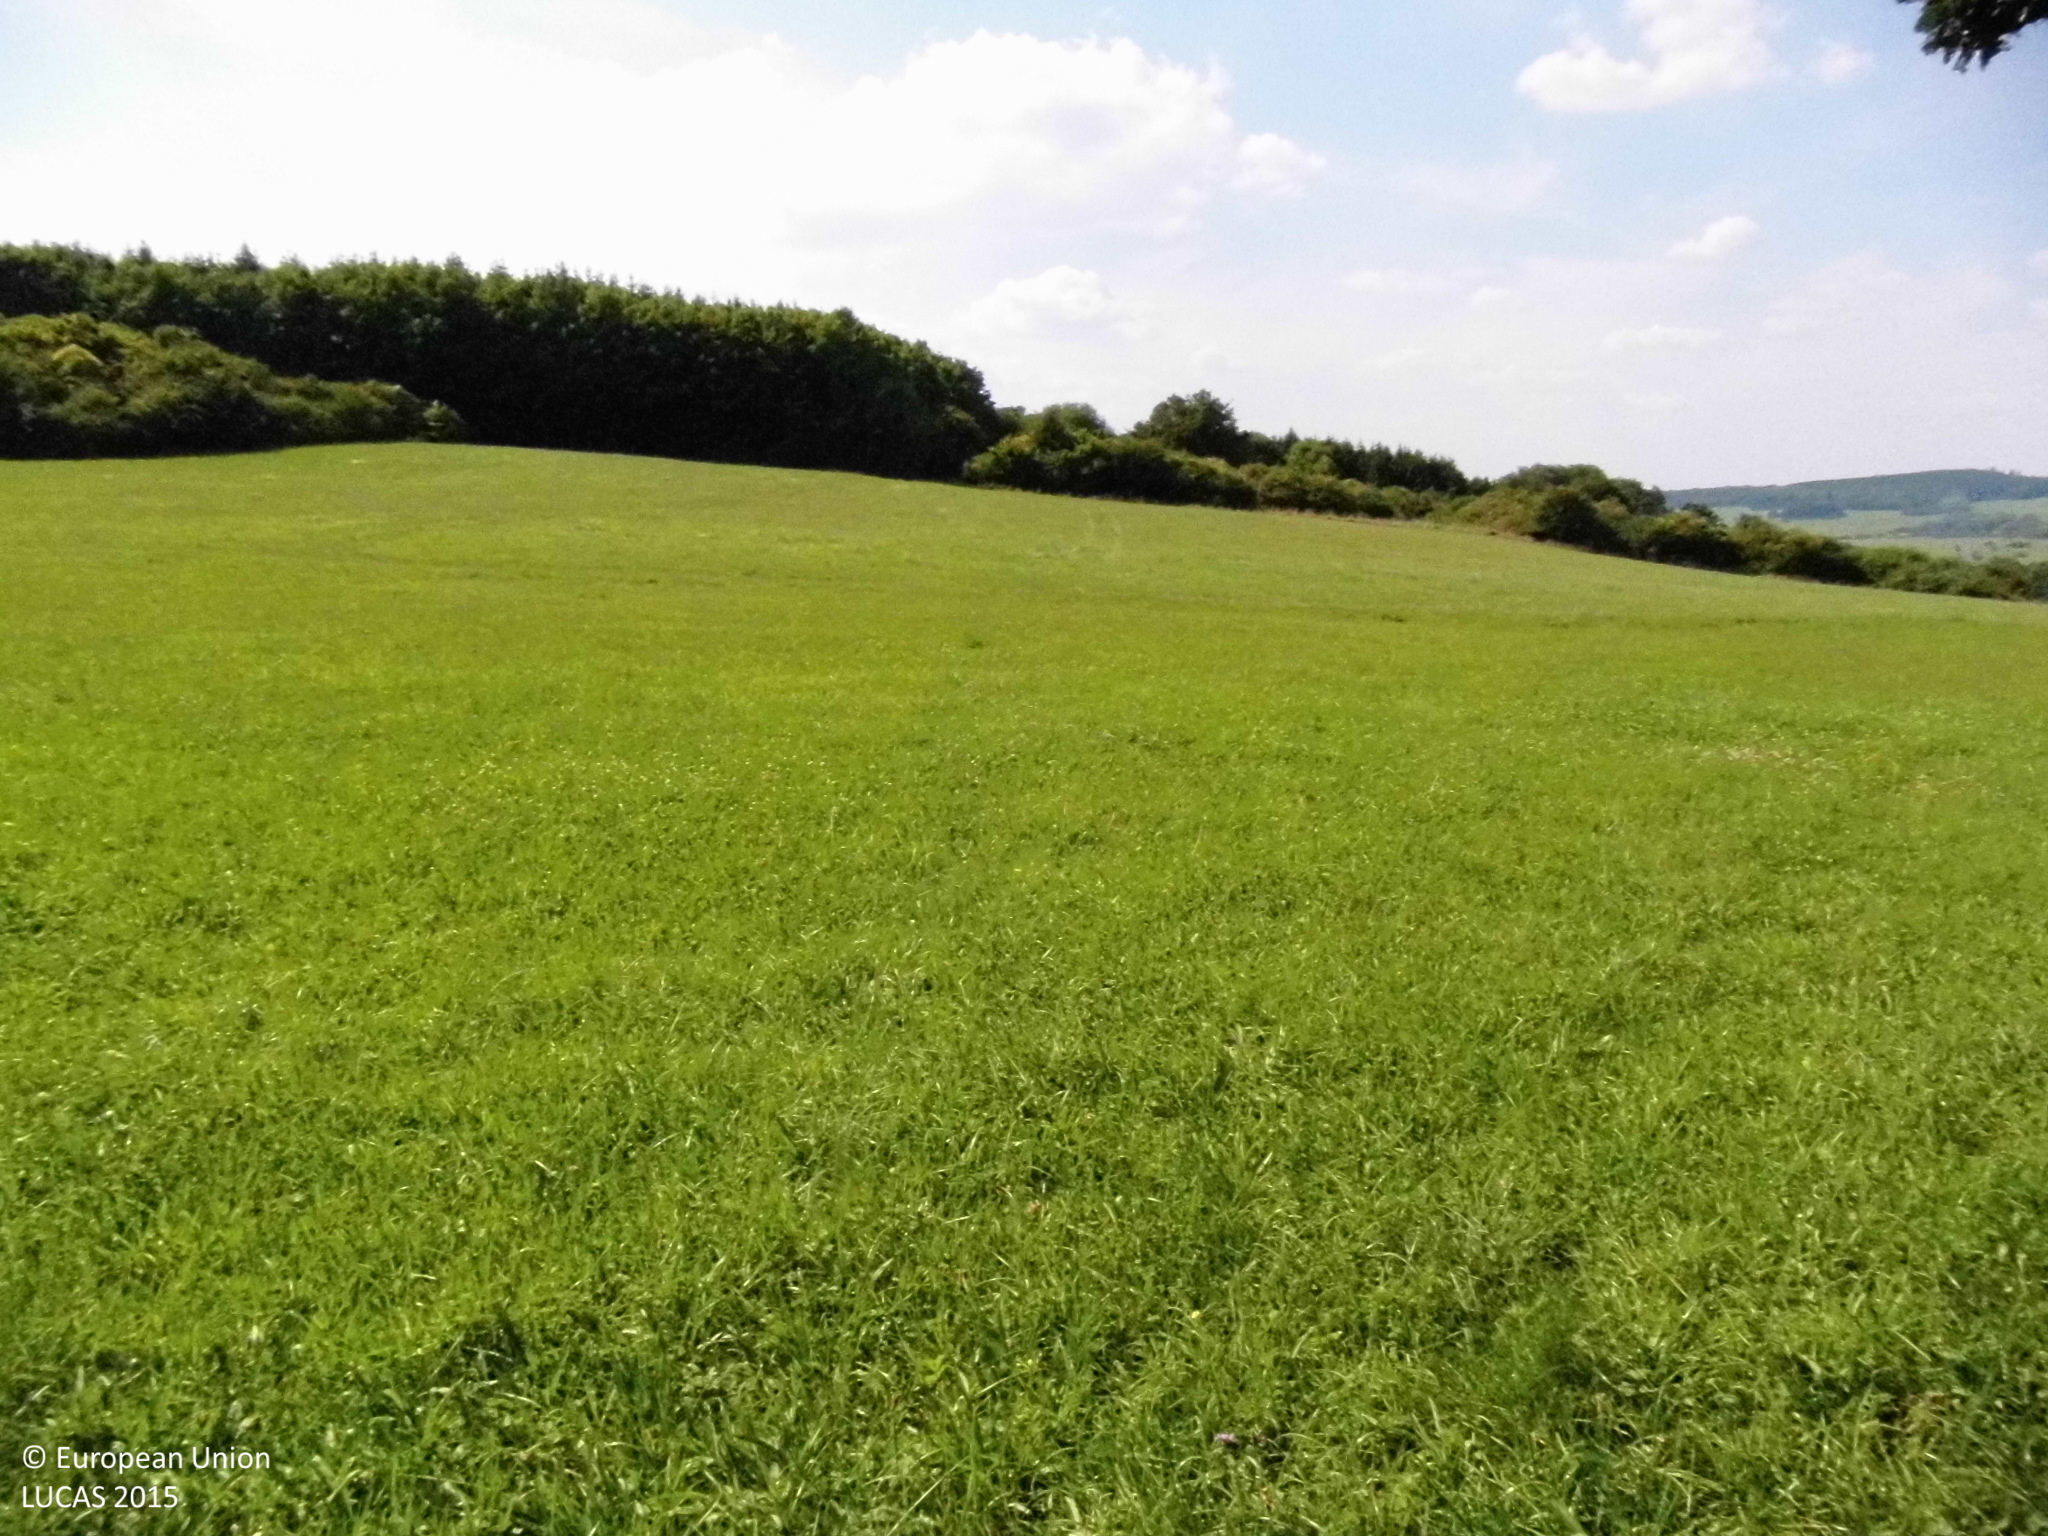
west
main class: Woodland
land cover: Broadleaved woodland
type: mesophytic deciduous forest
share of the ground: > 75 %
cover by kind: broadleaved forest trees 100 %
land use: Forestry
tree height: > 5 m
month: August
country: DE
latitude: 50.5645
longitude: 8.1227
